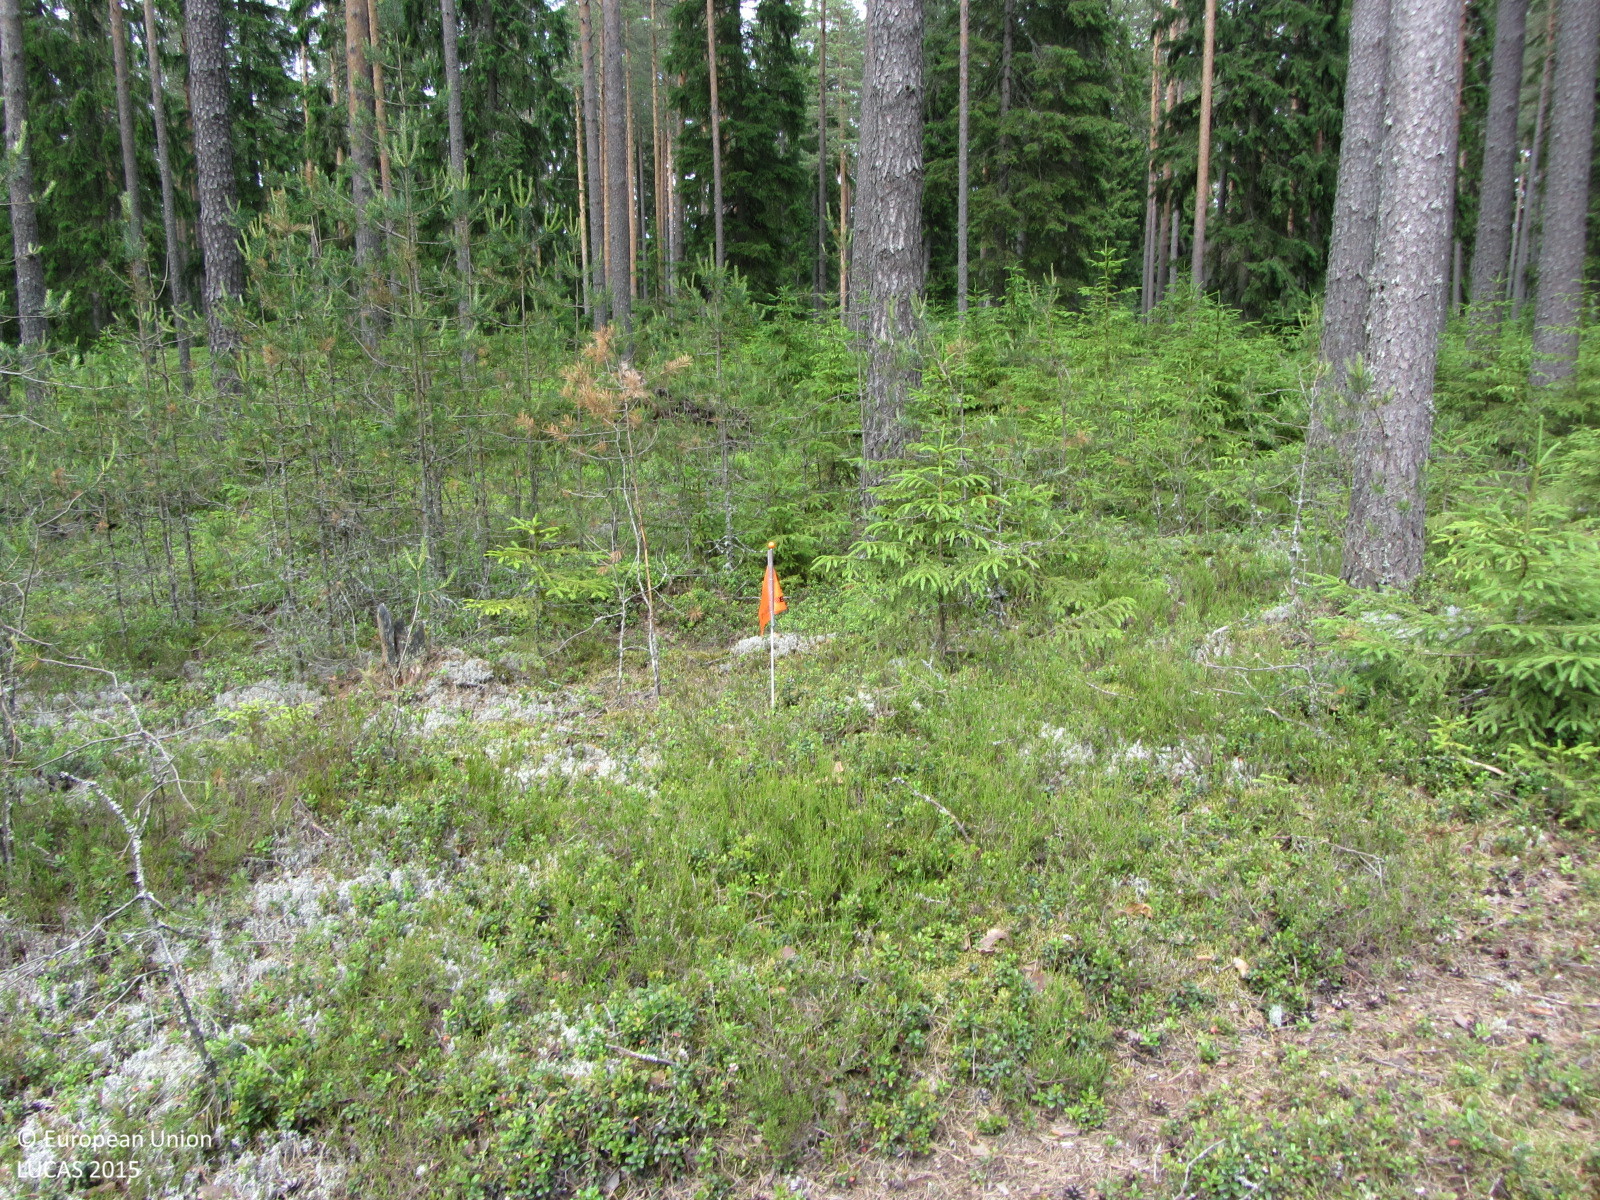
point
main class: Woodland
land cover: Other coniferous woodland
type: boreal forest
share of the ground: > 75 %
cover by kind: coniferous forest trees 75 %, shrubs 15 %, lichens and mosses 10 %
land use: Forestry
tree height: > 5 m
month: June
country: FI
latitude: 60.1057
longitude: 23.1969
